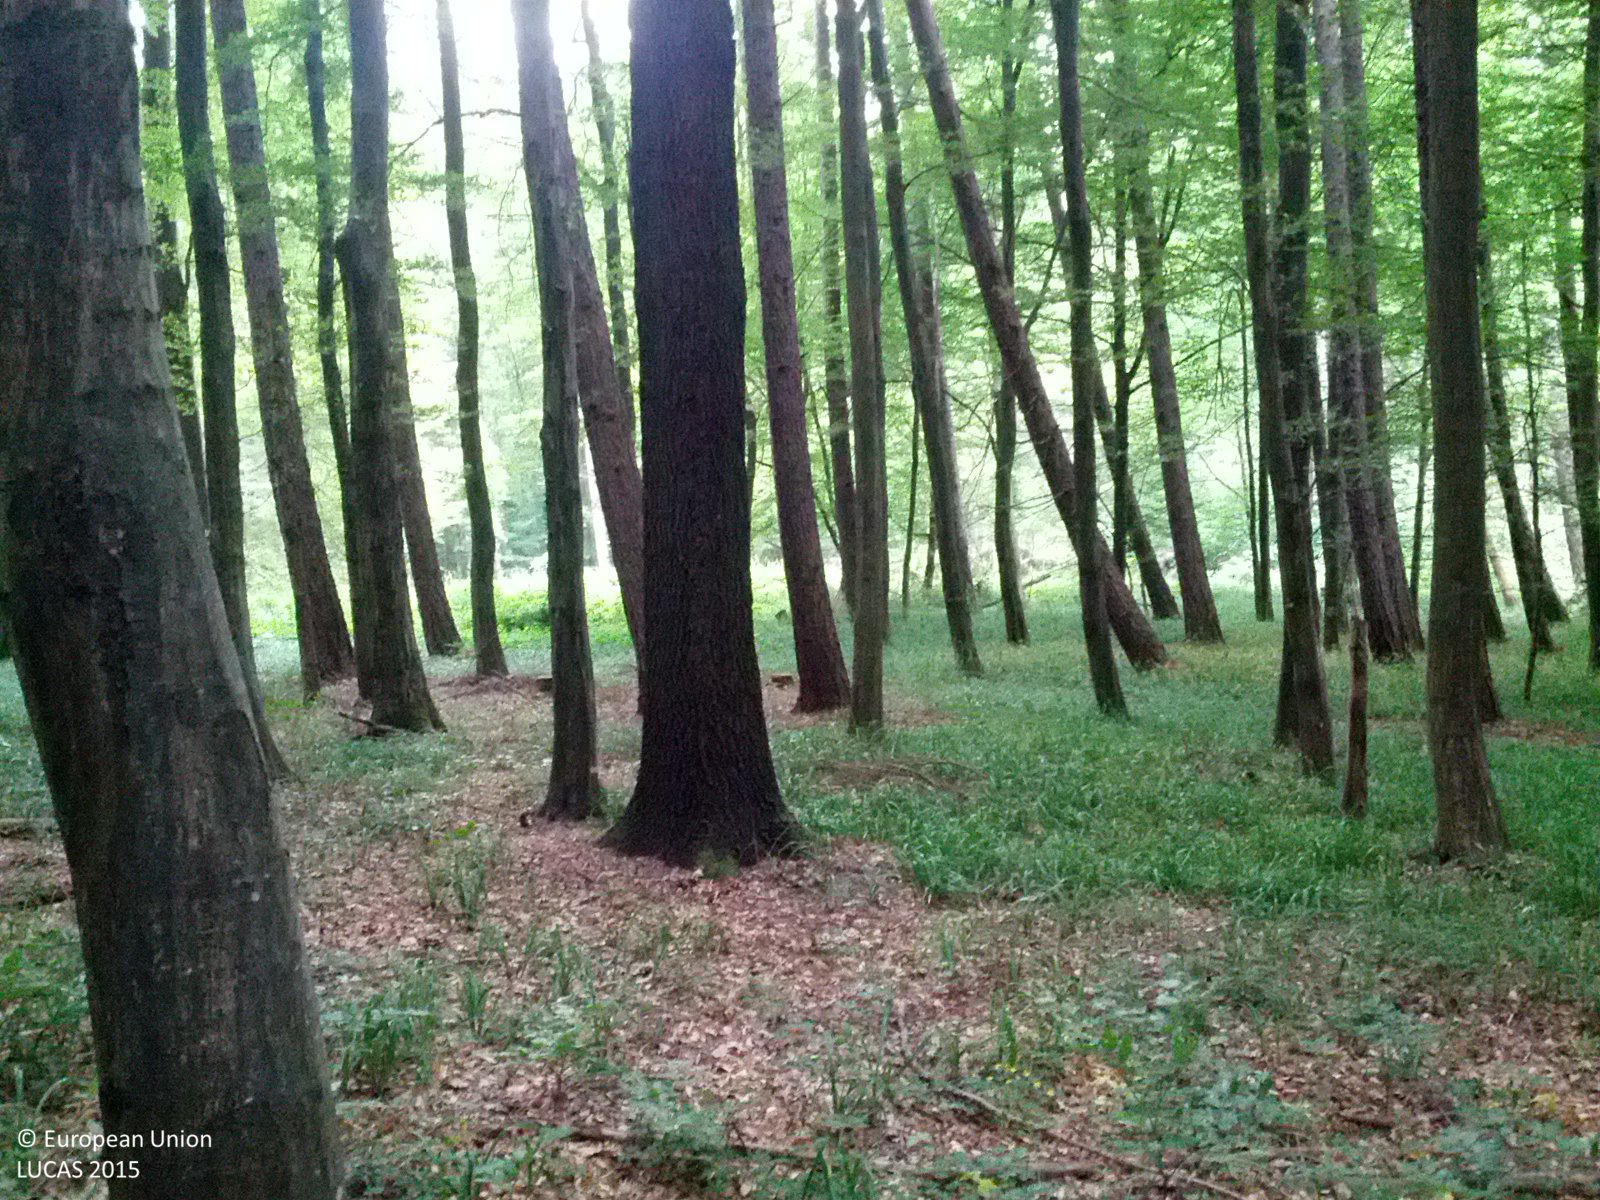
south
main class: Woodland
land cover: Other mixed woodland
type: alpine coniferous forest
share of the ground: > 75 %
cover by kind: coniferous forest trees 40 %, broadleaved forest trees 40 %, herbaceous plants 15 %, shrubs 5 %
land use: Forestry
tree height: > 5 m
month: June
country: AT
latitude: 48.1976
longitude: 16.1257
